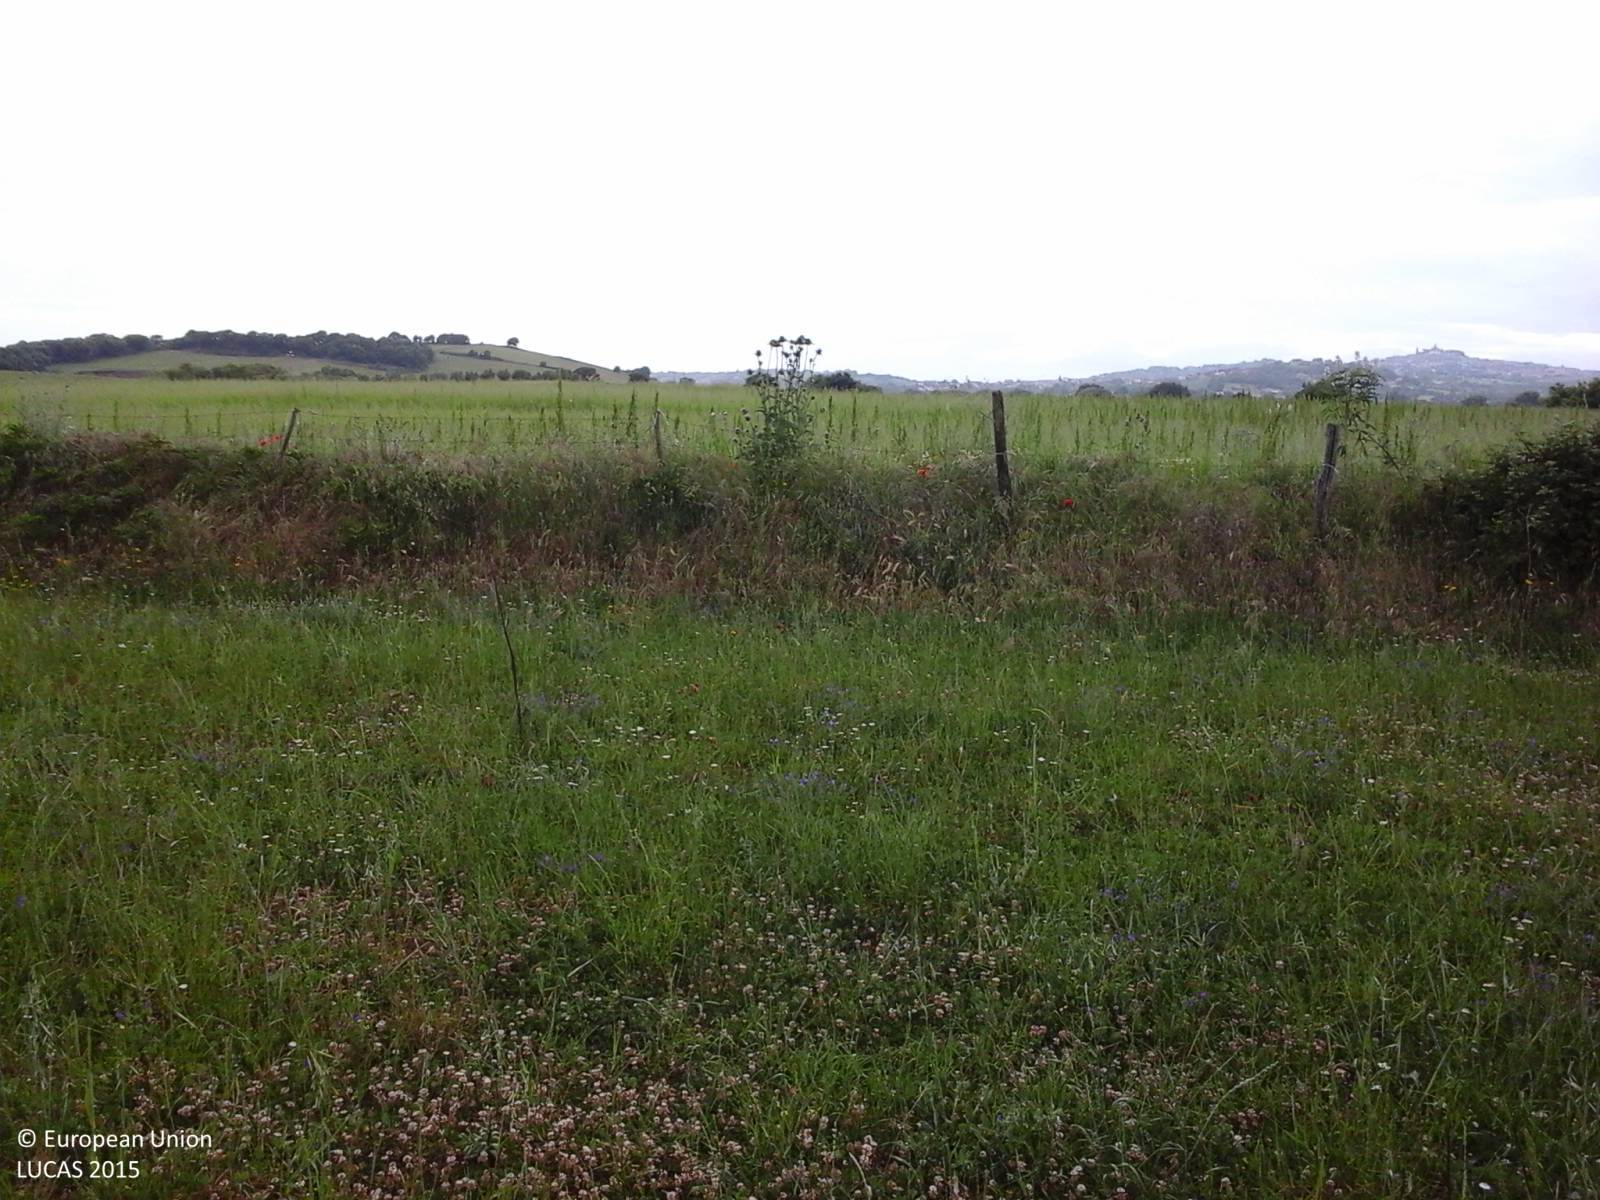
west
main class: Cropland
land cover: Other leguminous and mixtures for fodder
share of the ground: > 75 %
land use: Agriculture (excluding fallow land and kitchen gardens)
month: May
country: IT
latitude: 42.5239
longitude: 12.0989
